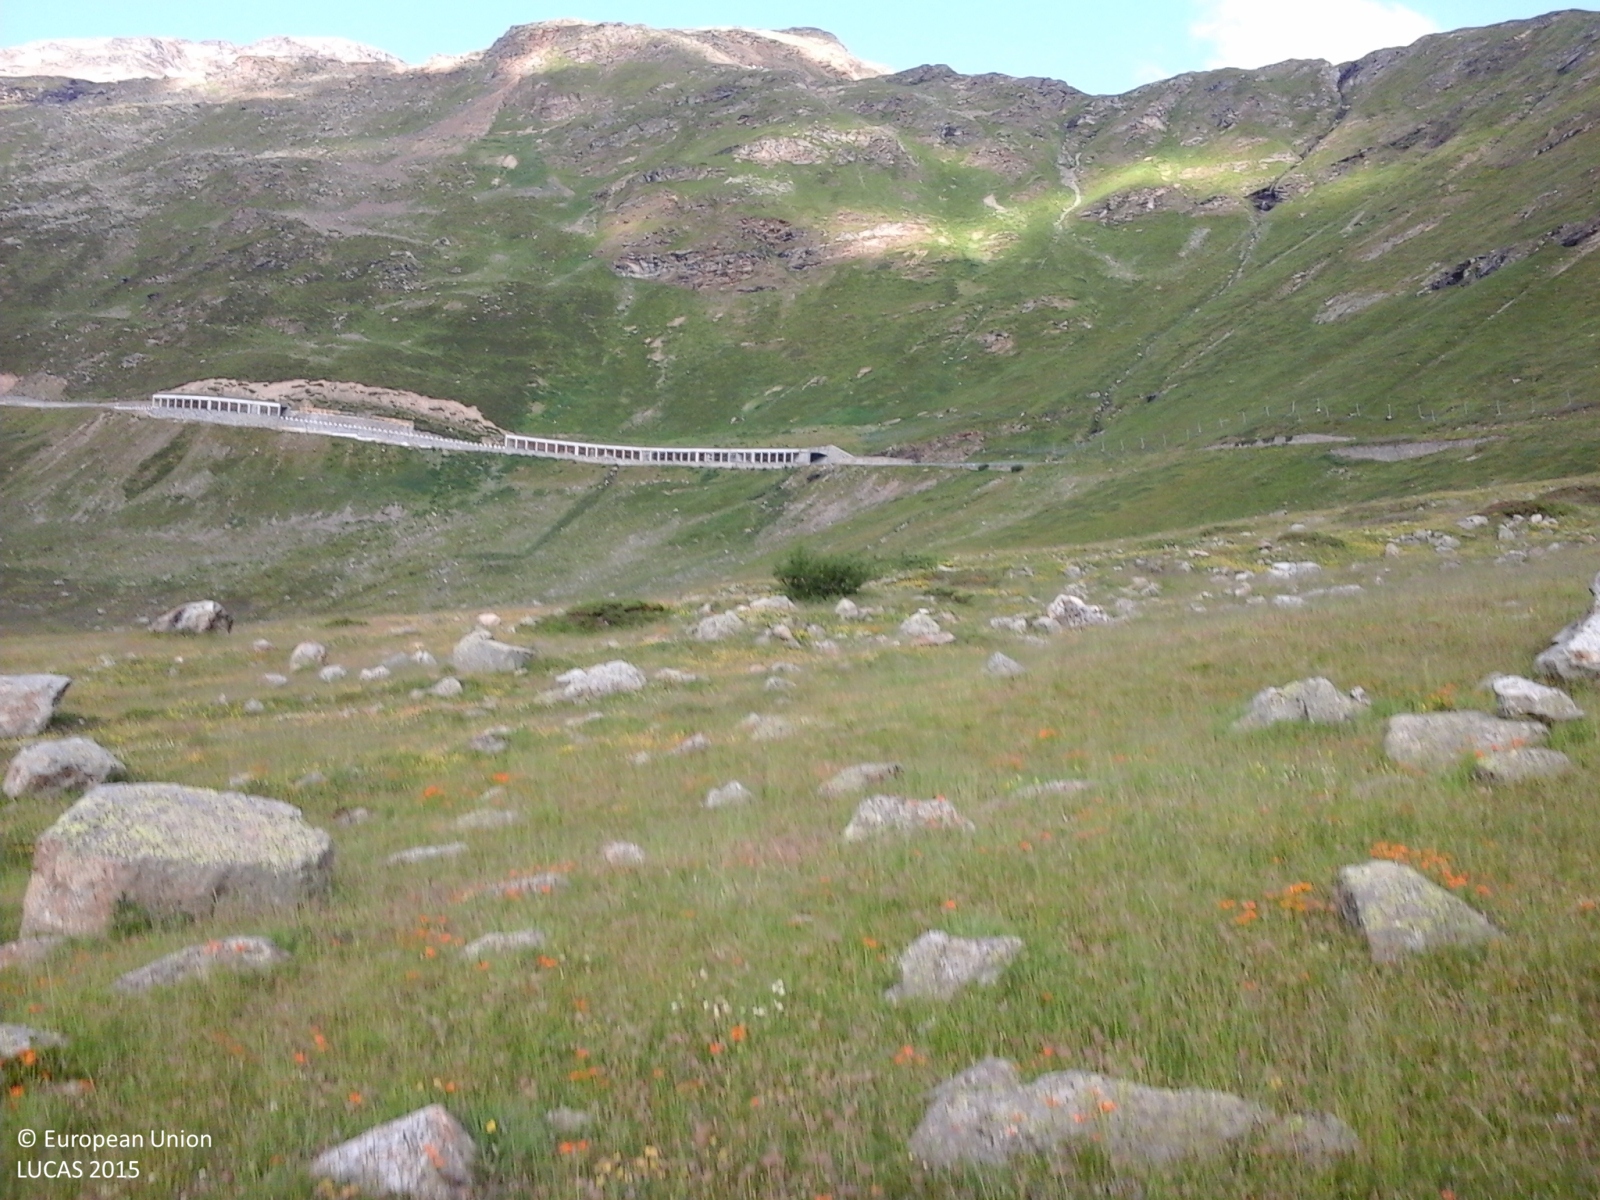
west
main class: Grassland
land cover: Grassland without tree/shrub cover
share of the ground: > 75 %
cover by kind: herbaceous plants 100 %
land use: Agriculture (excluding fallow land and kitchen gardens)
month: July
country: IT
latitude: 46.4592
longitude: 10.0650
